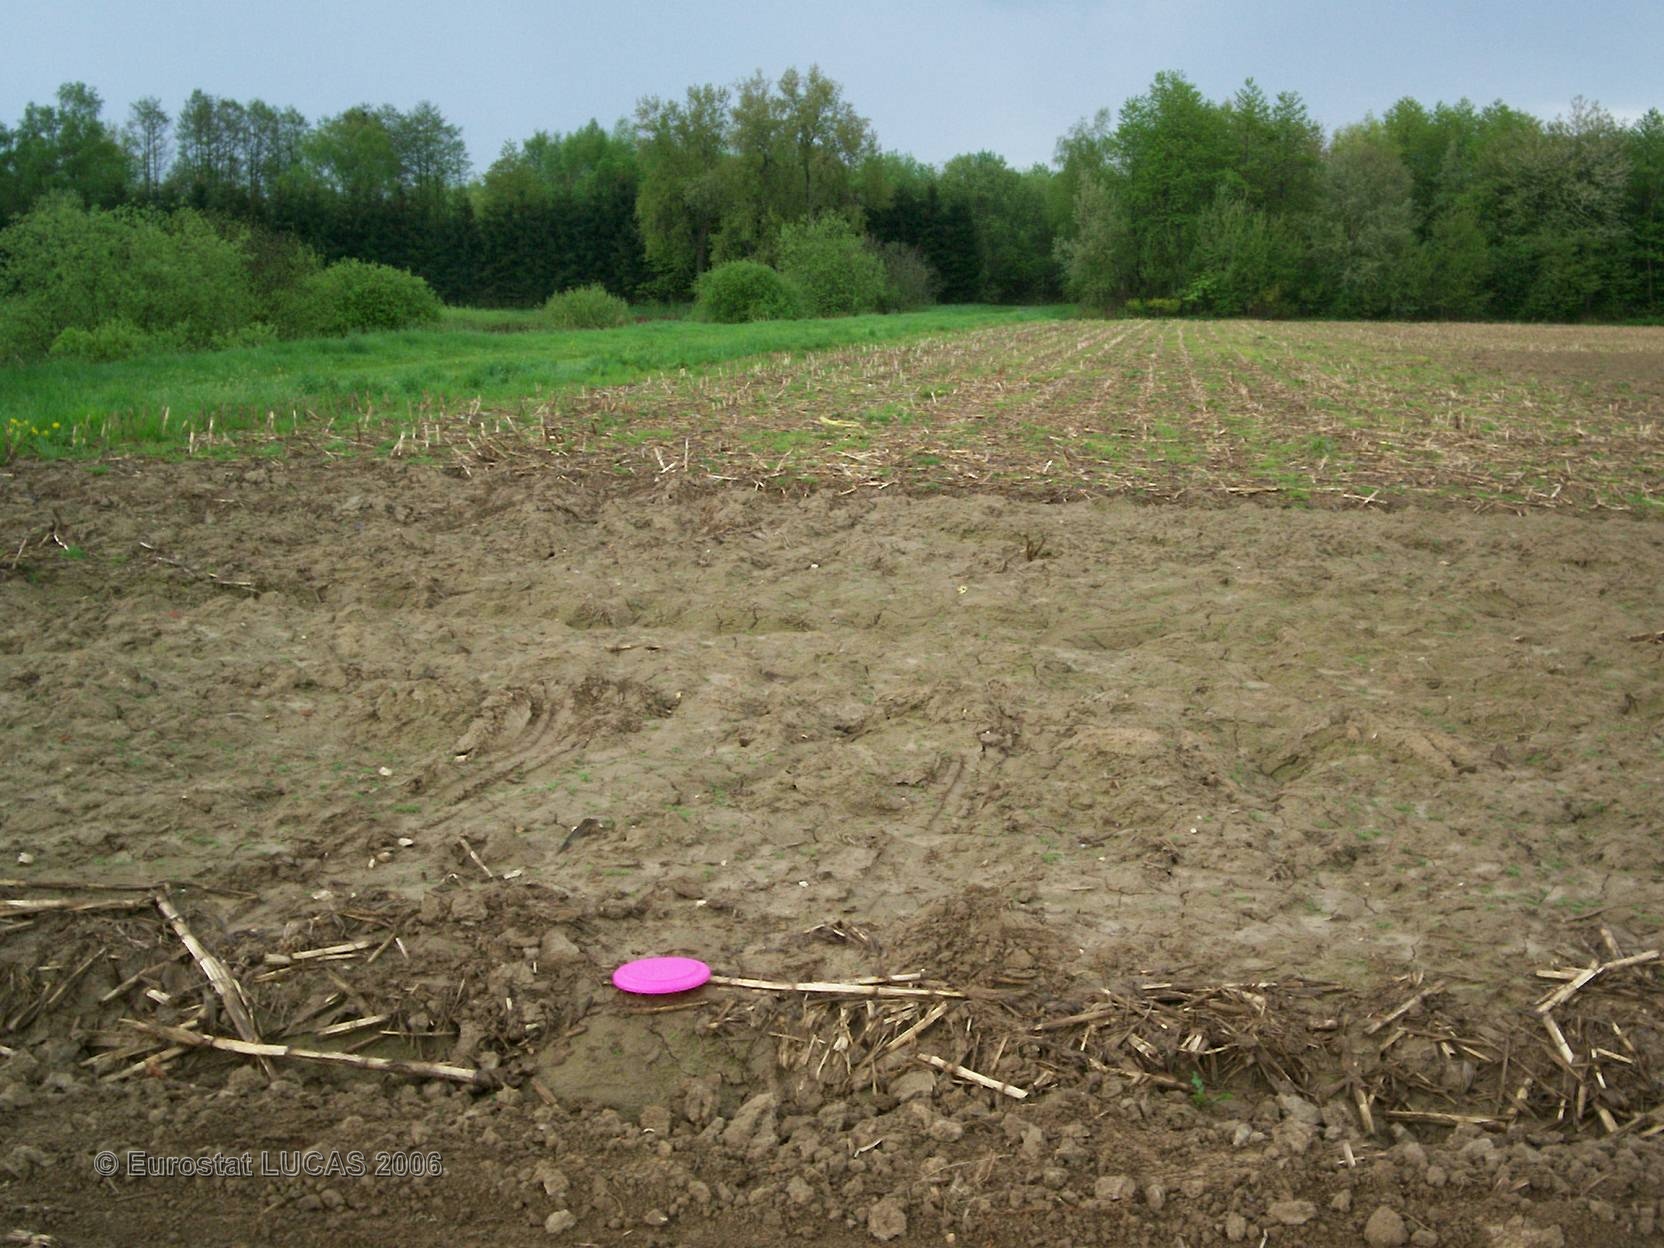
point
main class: Cropland
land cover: Maize
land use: Agriculture (excluding fallow land and kitchen gardens)
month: May
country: FR
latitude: 47.6426
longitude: 7.0065
